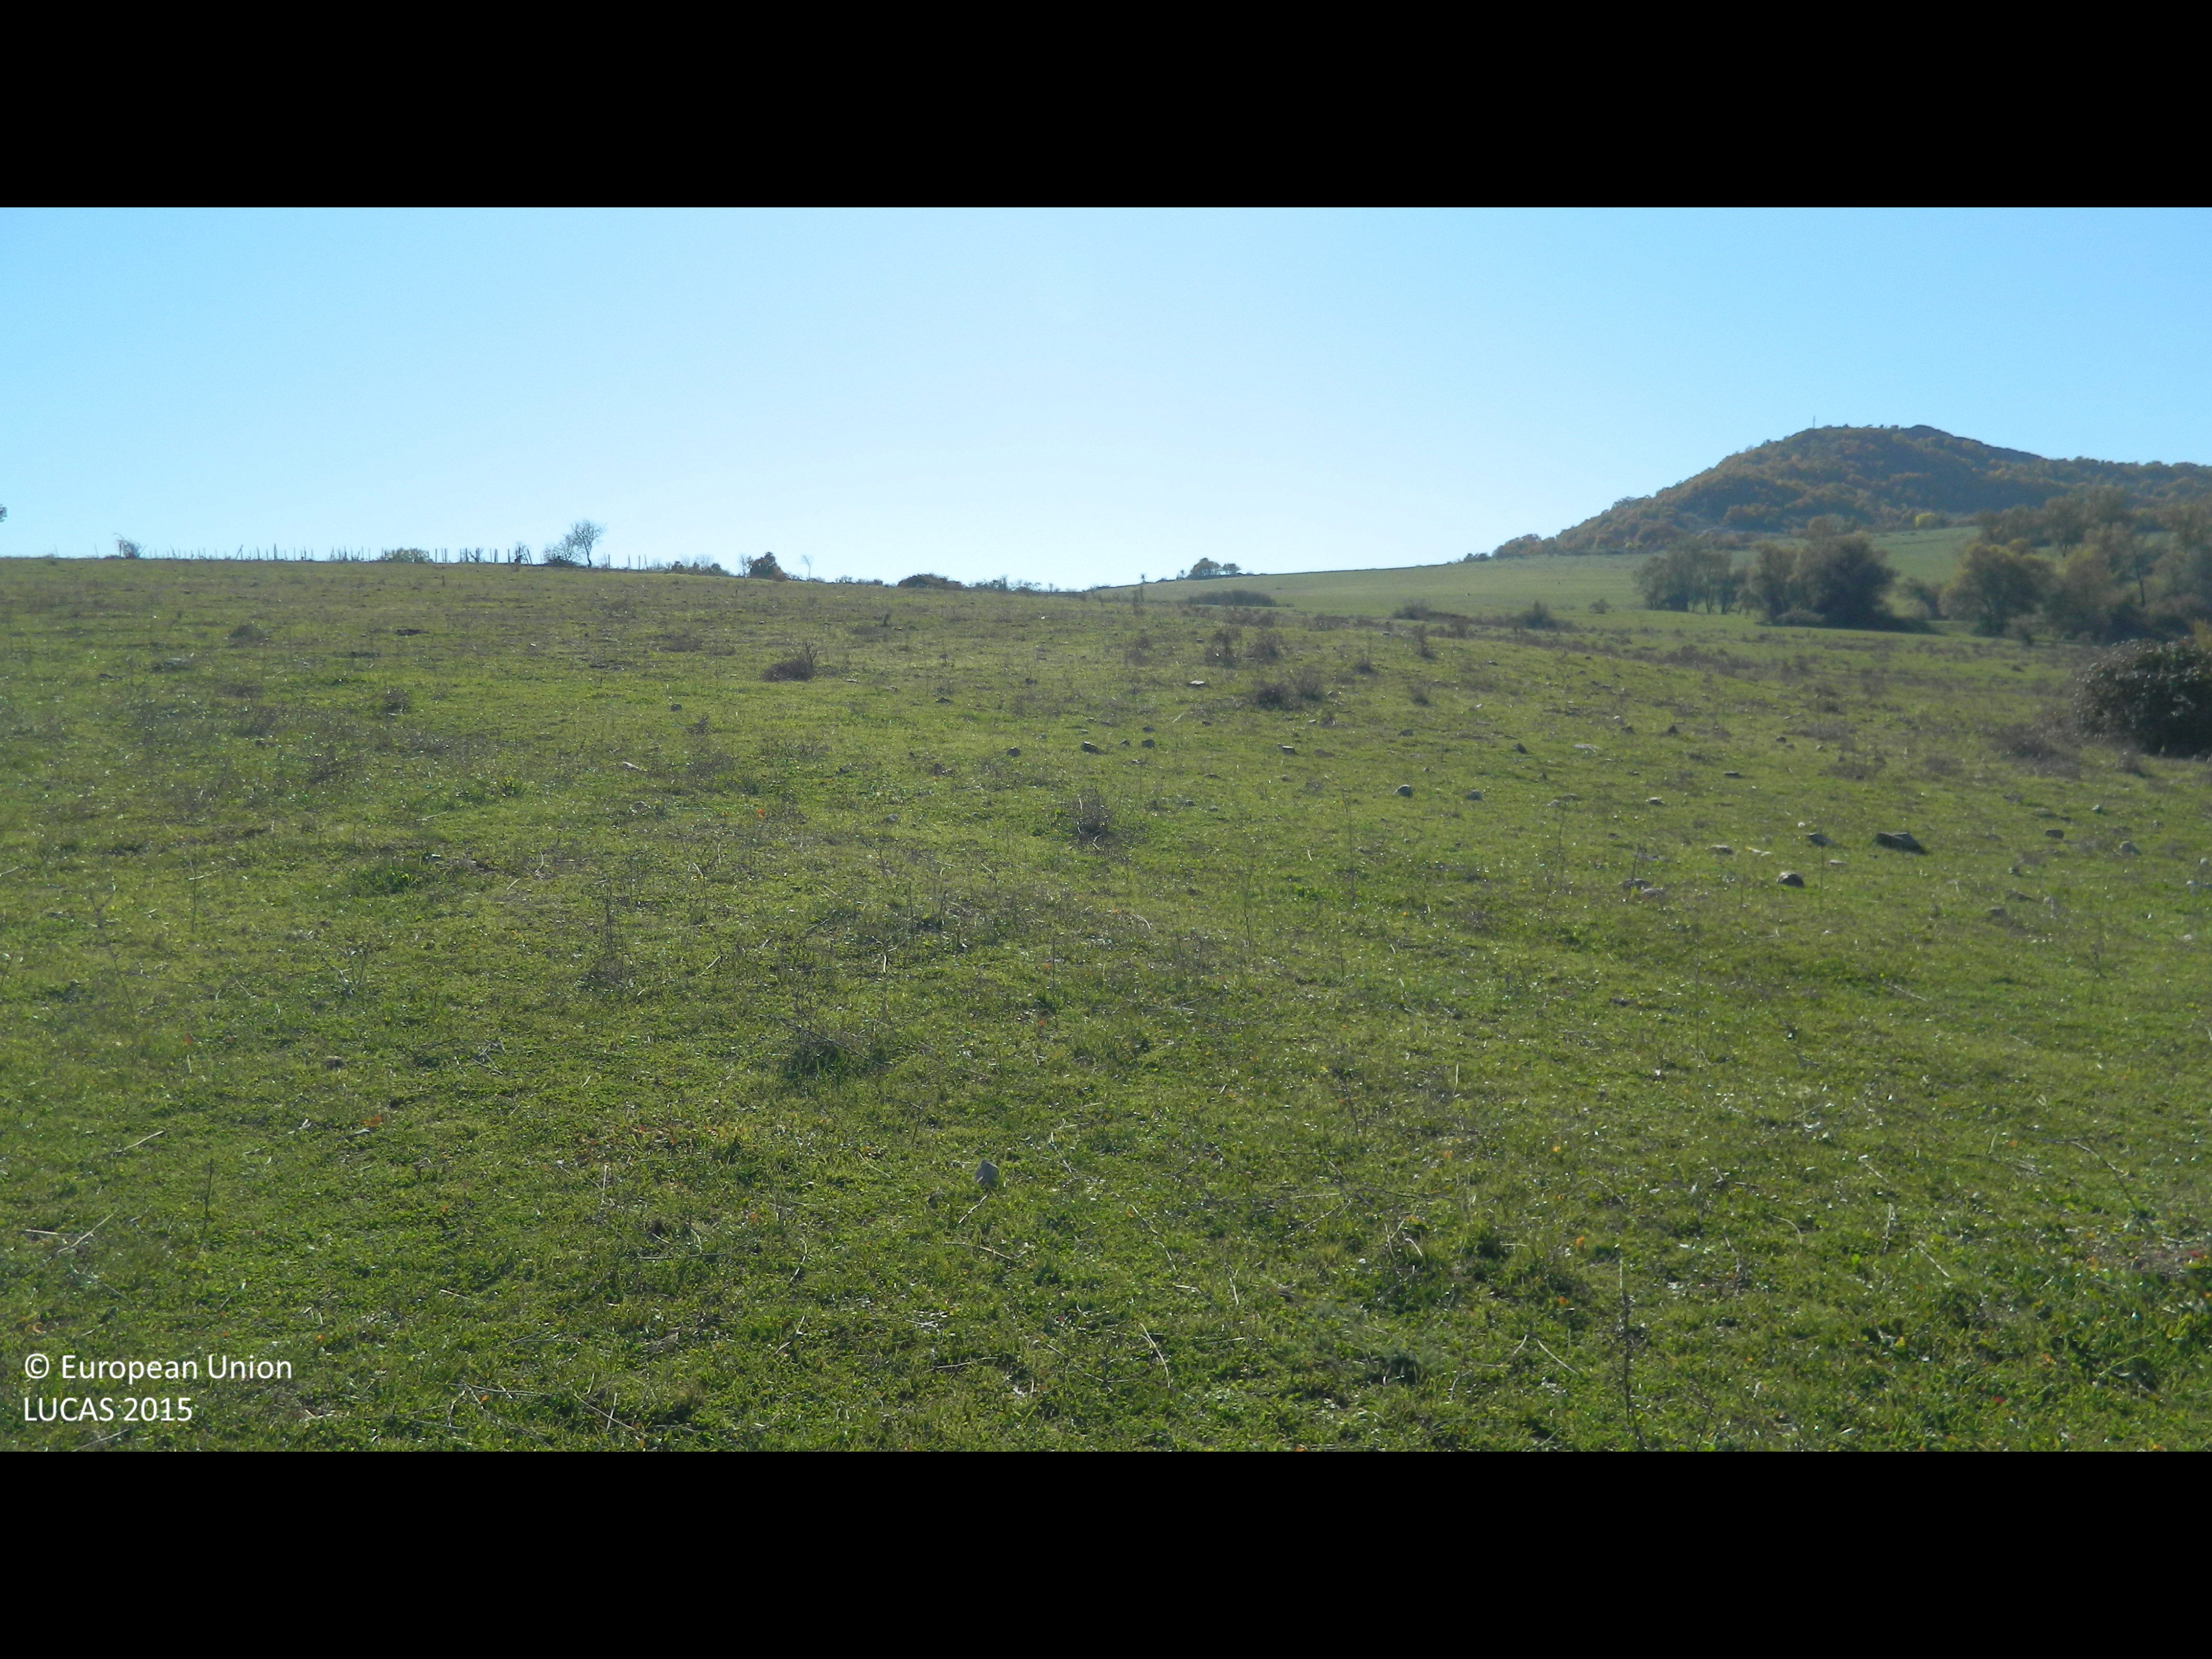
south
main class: Grassland
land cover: Grassland without tree/shrub cover
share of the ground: > 75 %
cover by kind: herbaceous plants 100 %
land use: Agriculture (excluding fallow land and kitchen gardens)
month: November
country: BG
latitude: 41.6200
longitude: 25.9464
